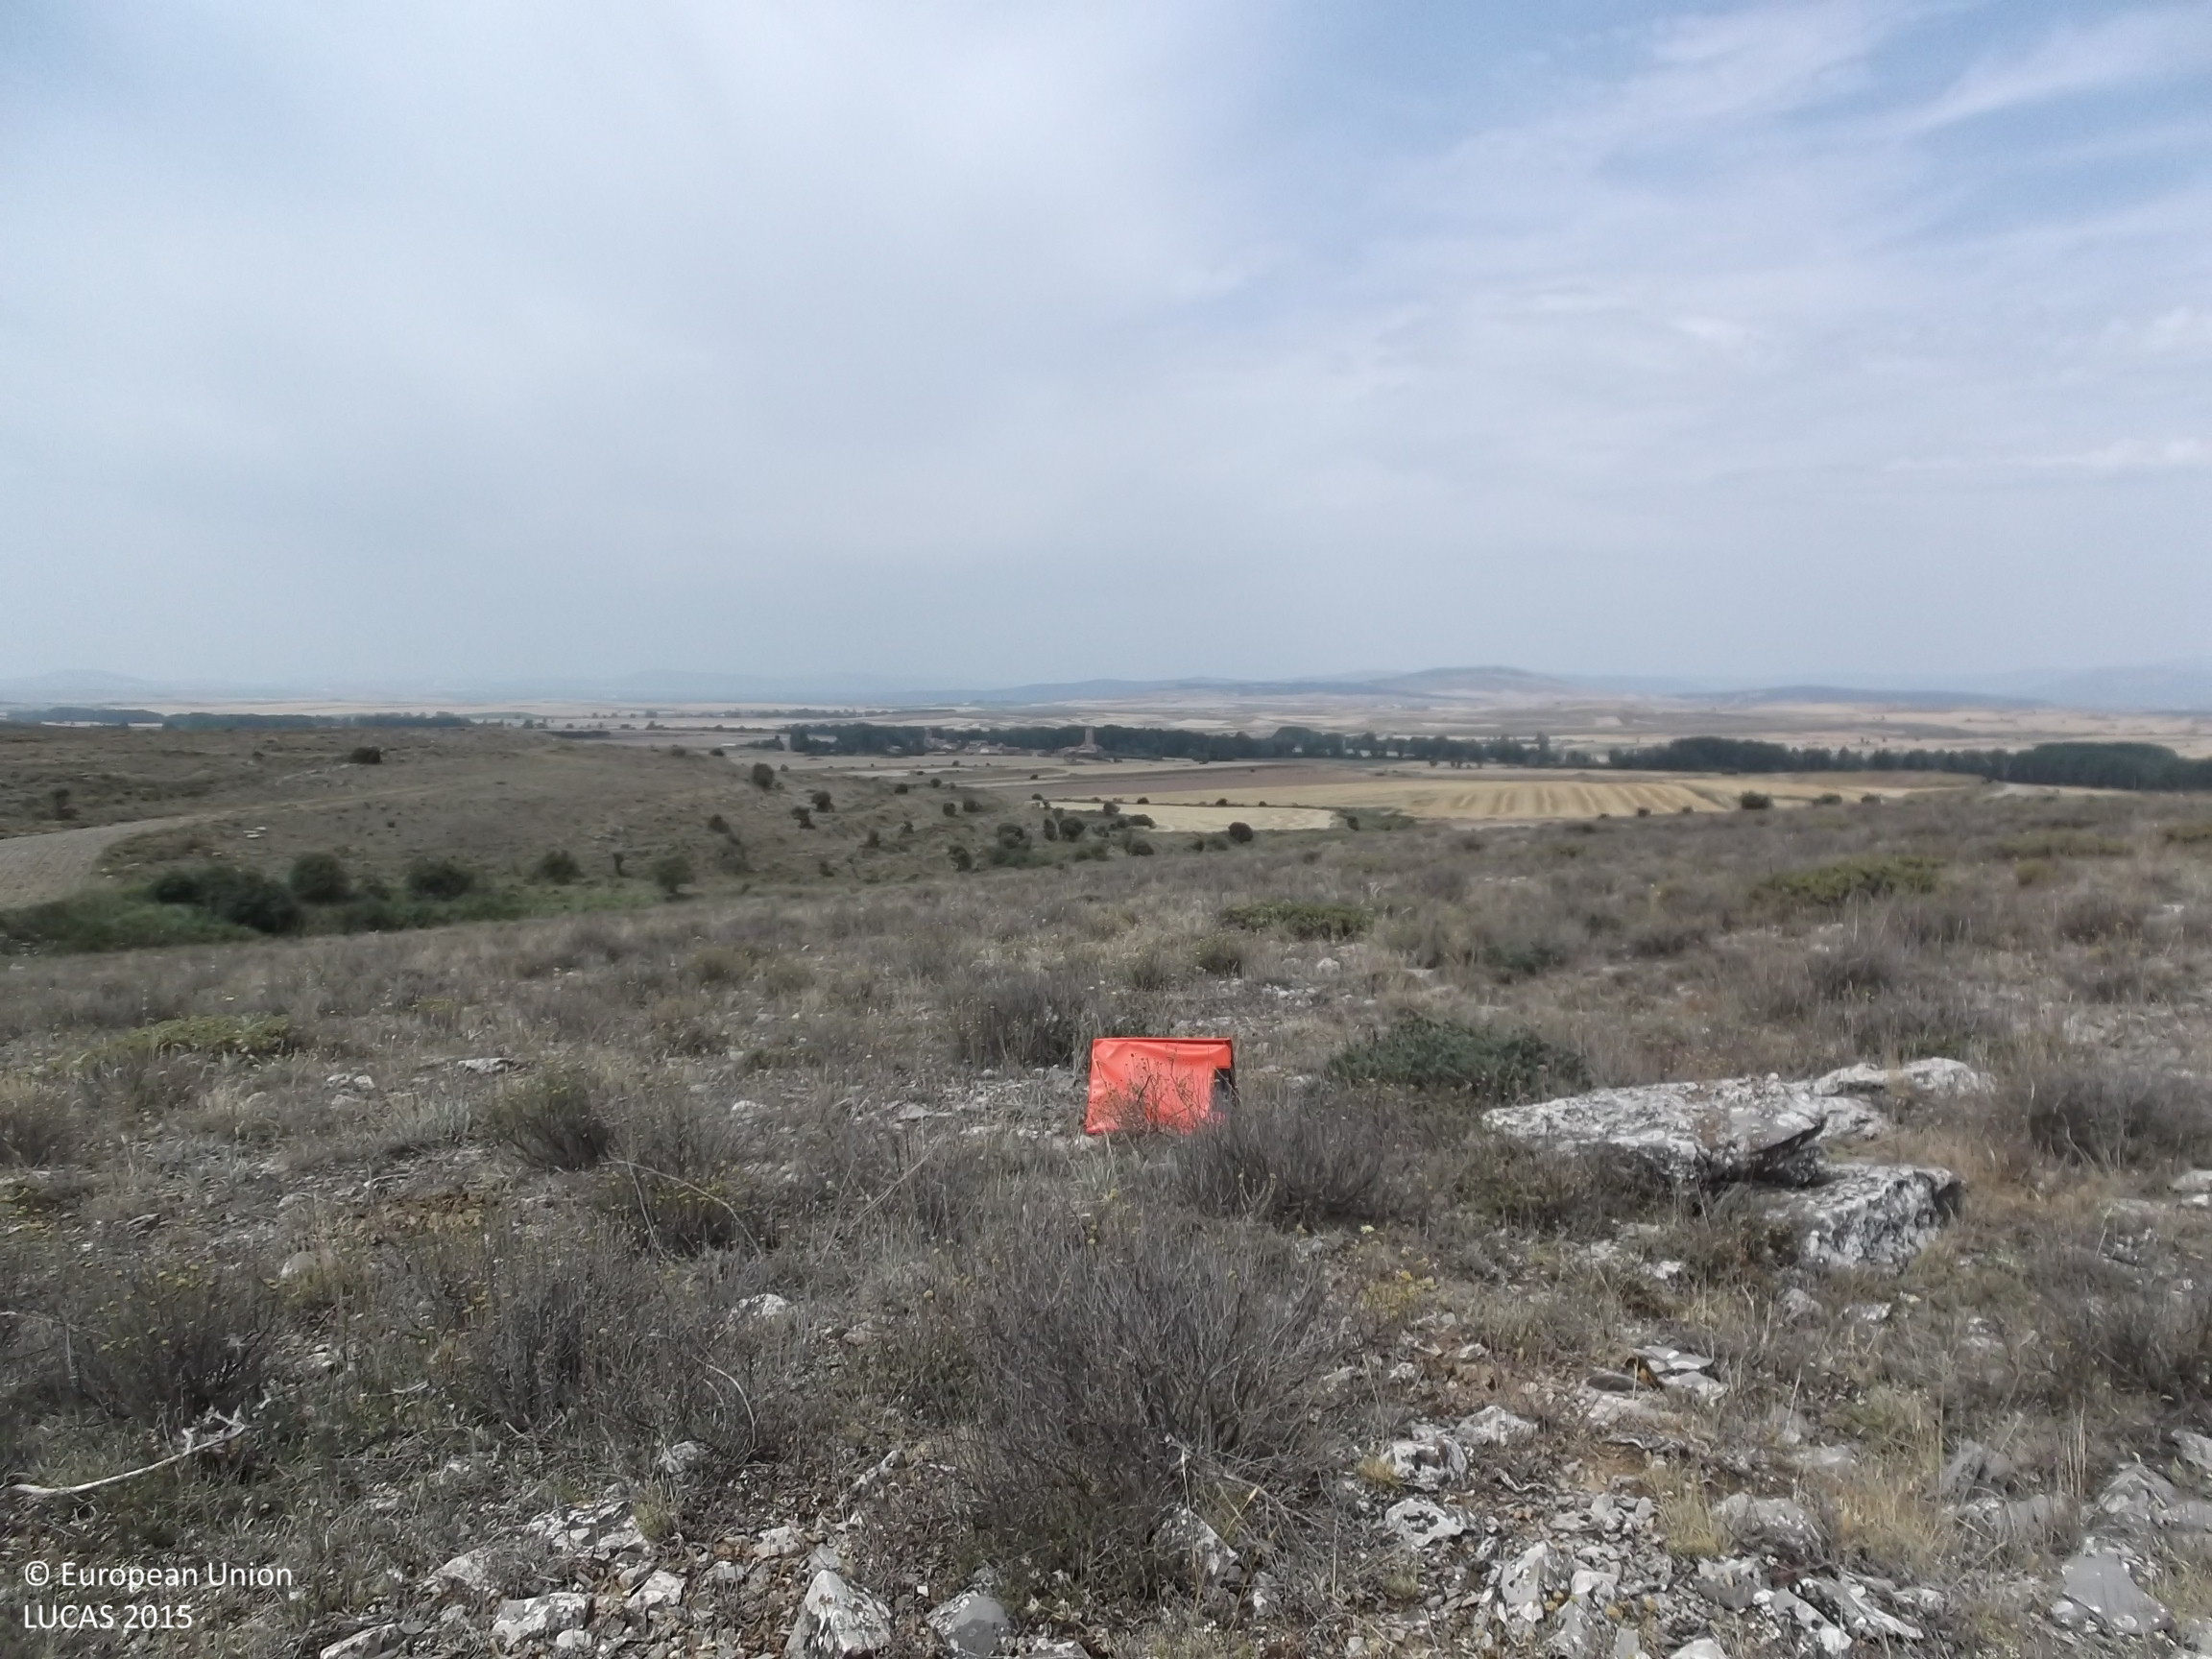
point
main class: Shrubland
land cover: Shrubland without tree cover
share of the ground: 50 - 75 %
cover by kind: shrubs 60 %, unconsolidated bare surface 30 %, herbaceous plants 10 %
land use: Semi-natural and natural areas not in use
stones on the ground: > 50 %
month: July
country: ES
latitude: 41.8839
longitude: -2.2930
